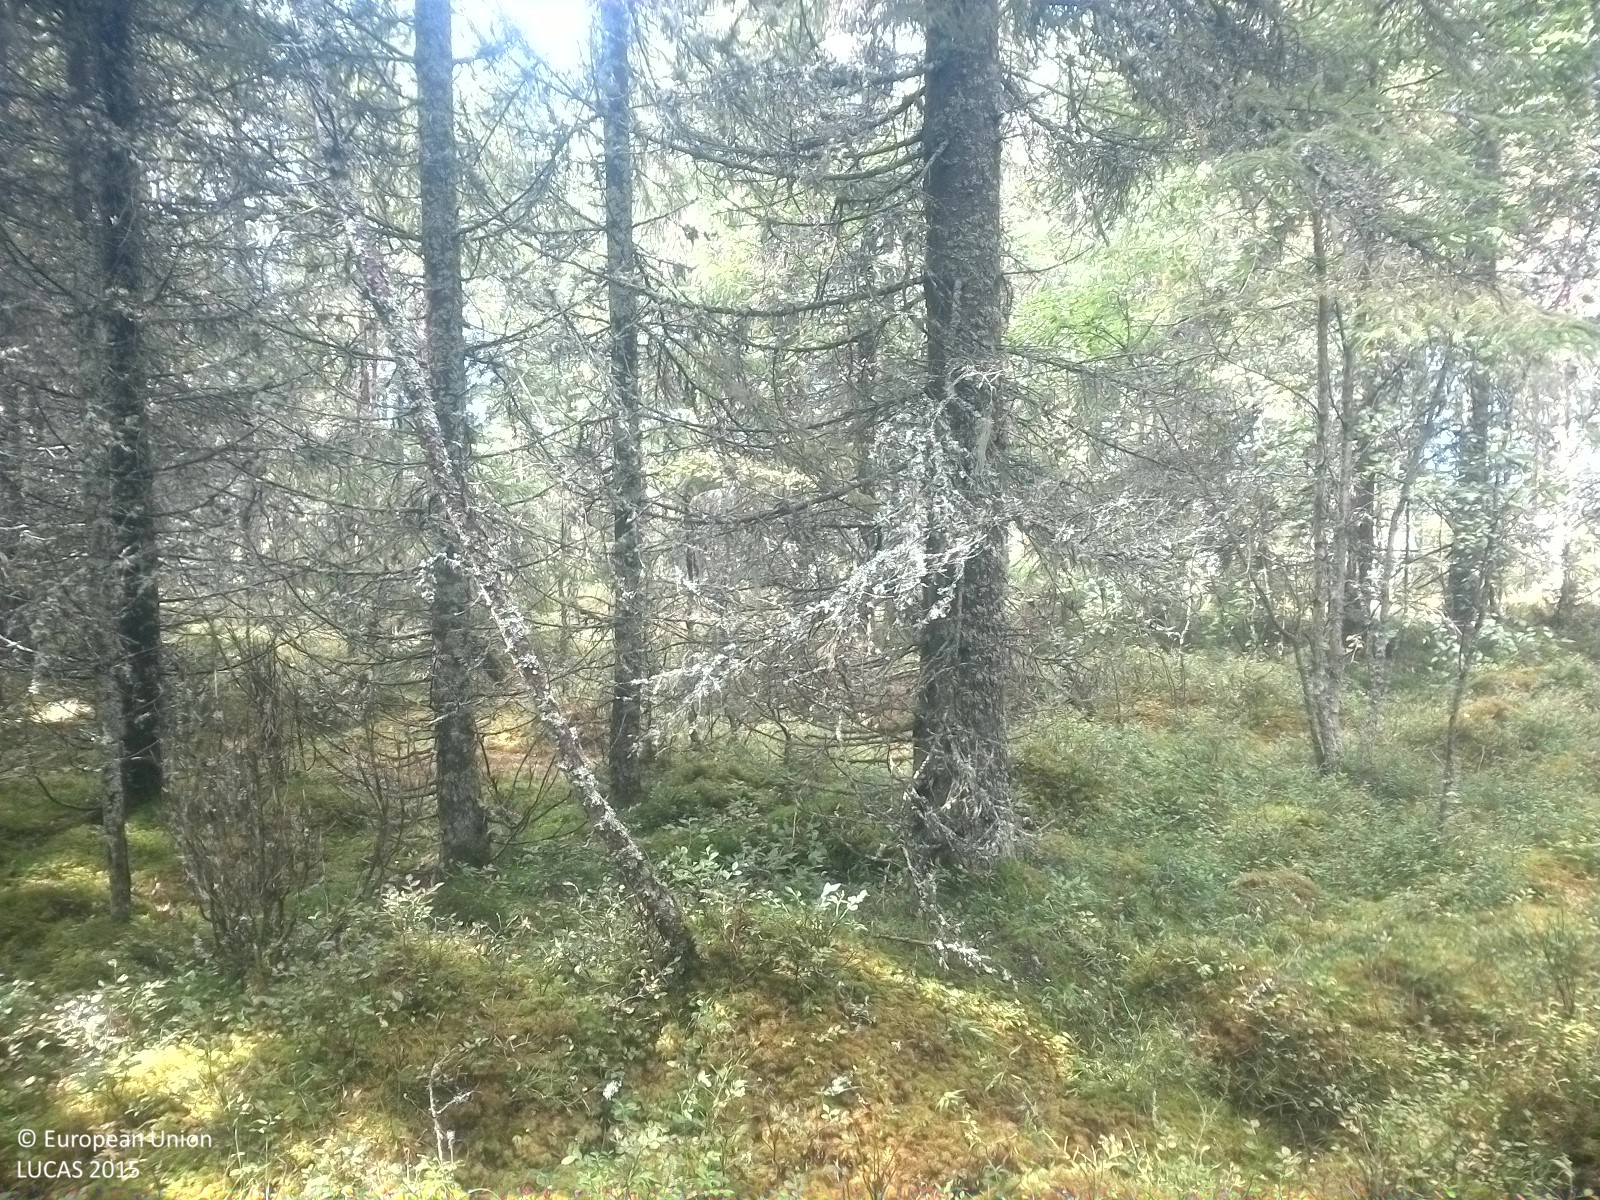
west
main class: Woodland
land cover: Spruce dominated coniferous woodland
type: boreal forest
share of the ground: 25 - 50 %
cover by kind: coniferous forest trees 40 %, herbaceous plants 25 %, lichens and mosses 25 %, broadleaved forest trees 5 %, shrubs 5 %
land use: Forestry
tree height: > 5 m
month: September
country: SE
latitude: 59.3985
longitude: 15.6801
